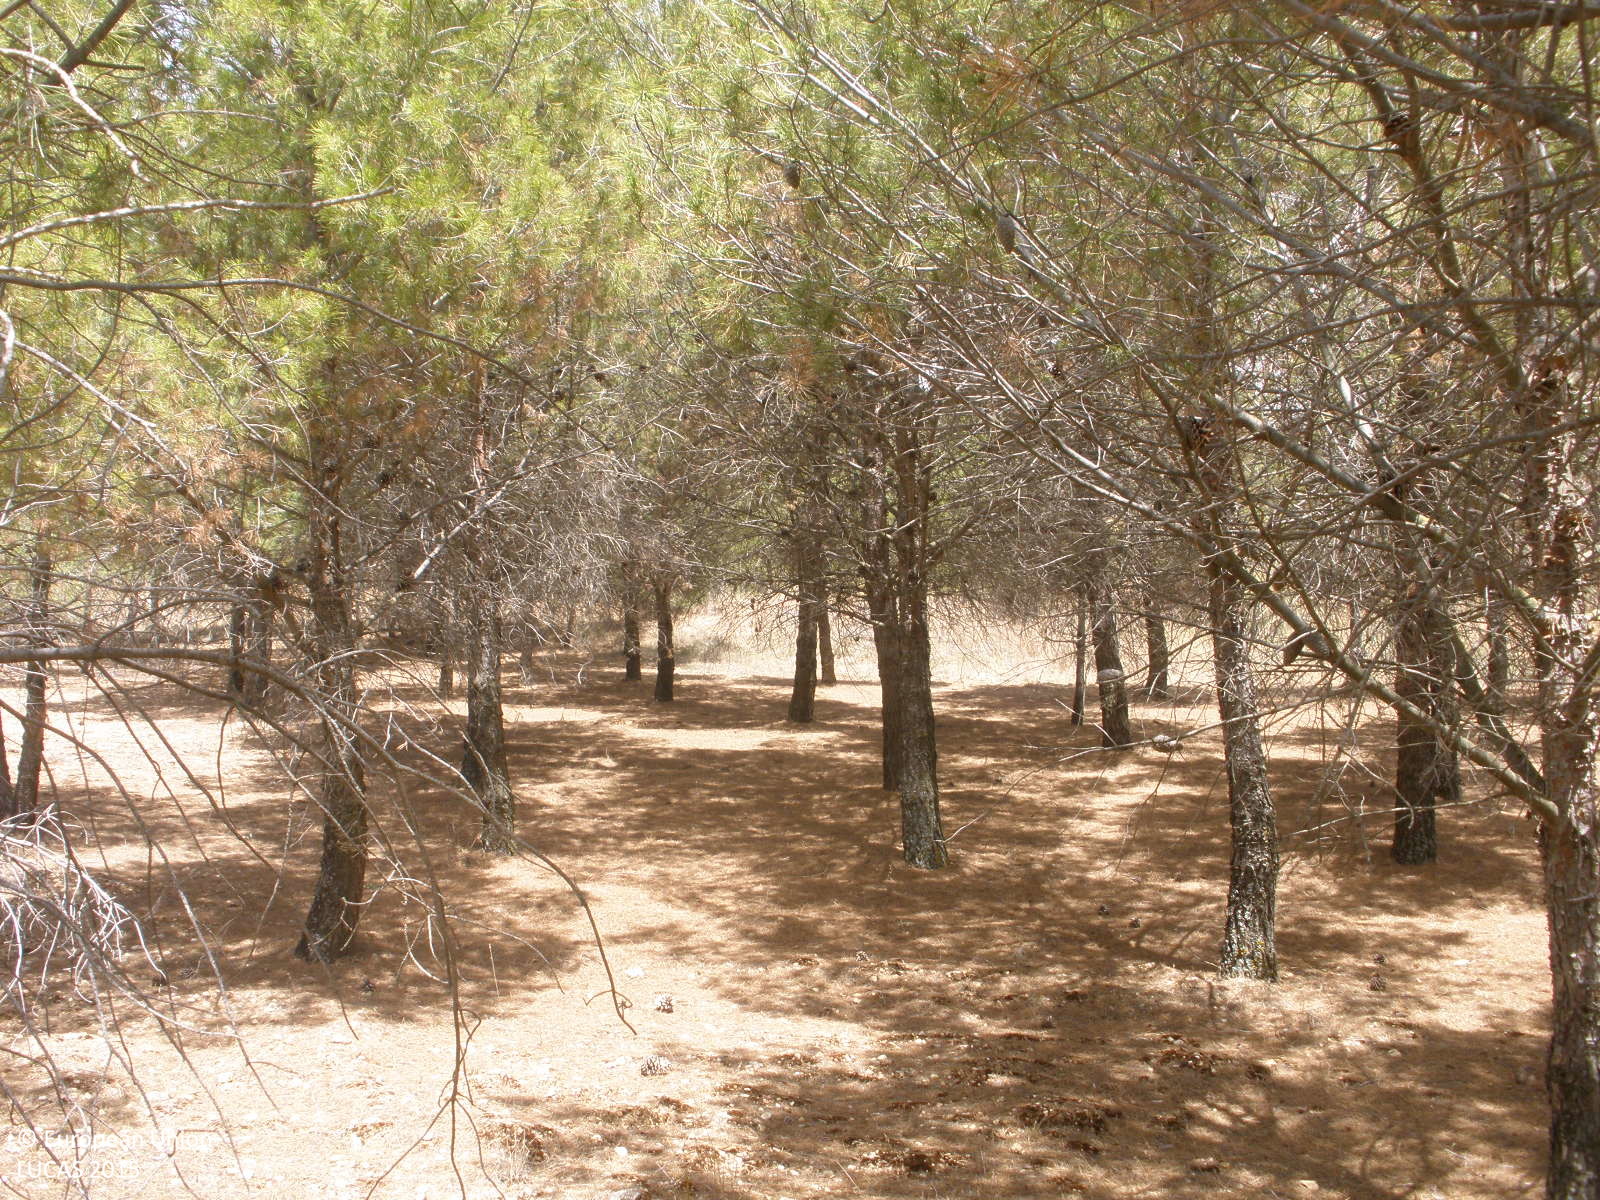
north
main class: Woodland
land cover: Pine dominated coniferous woodland
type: coniferous forest of the mediterranean region
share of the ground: 50 - 75 %
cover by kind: coniferous forest trees 70 %, herbaceous plants 20 %, consolidated bare surface 10 %
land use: Forestry
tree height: > 5 m
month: July
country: ES
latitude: 39.8194
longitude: -3.4024
